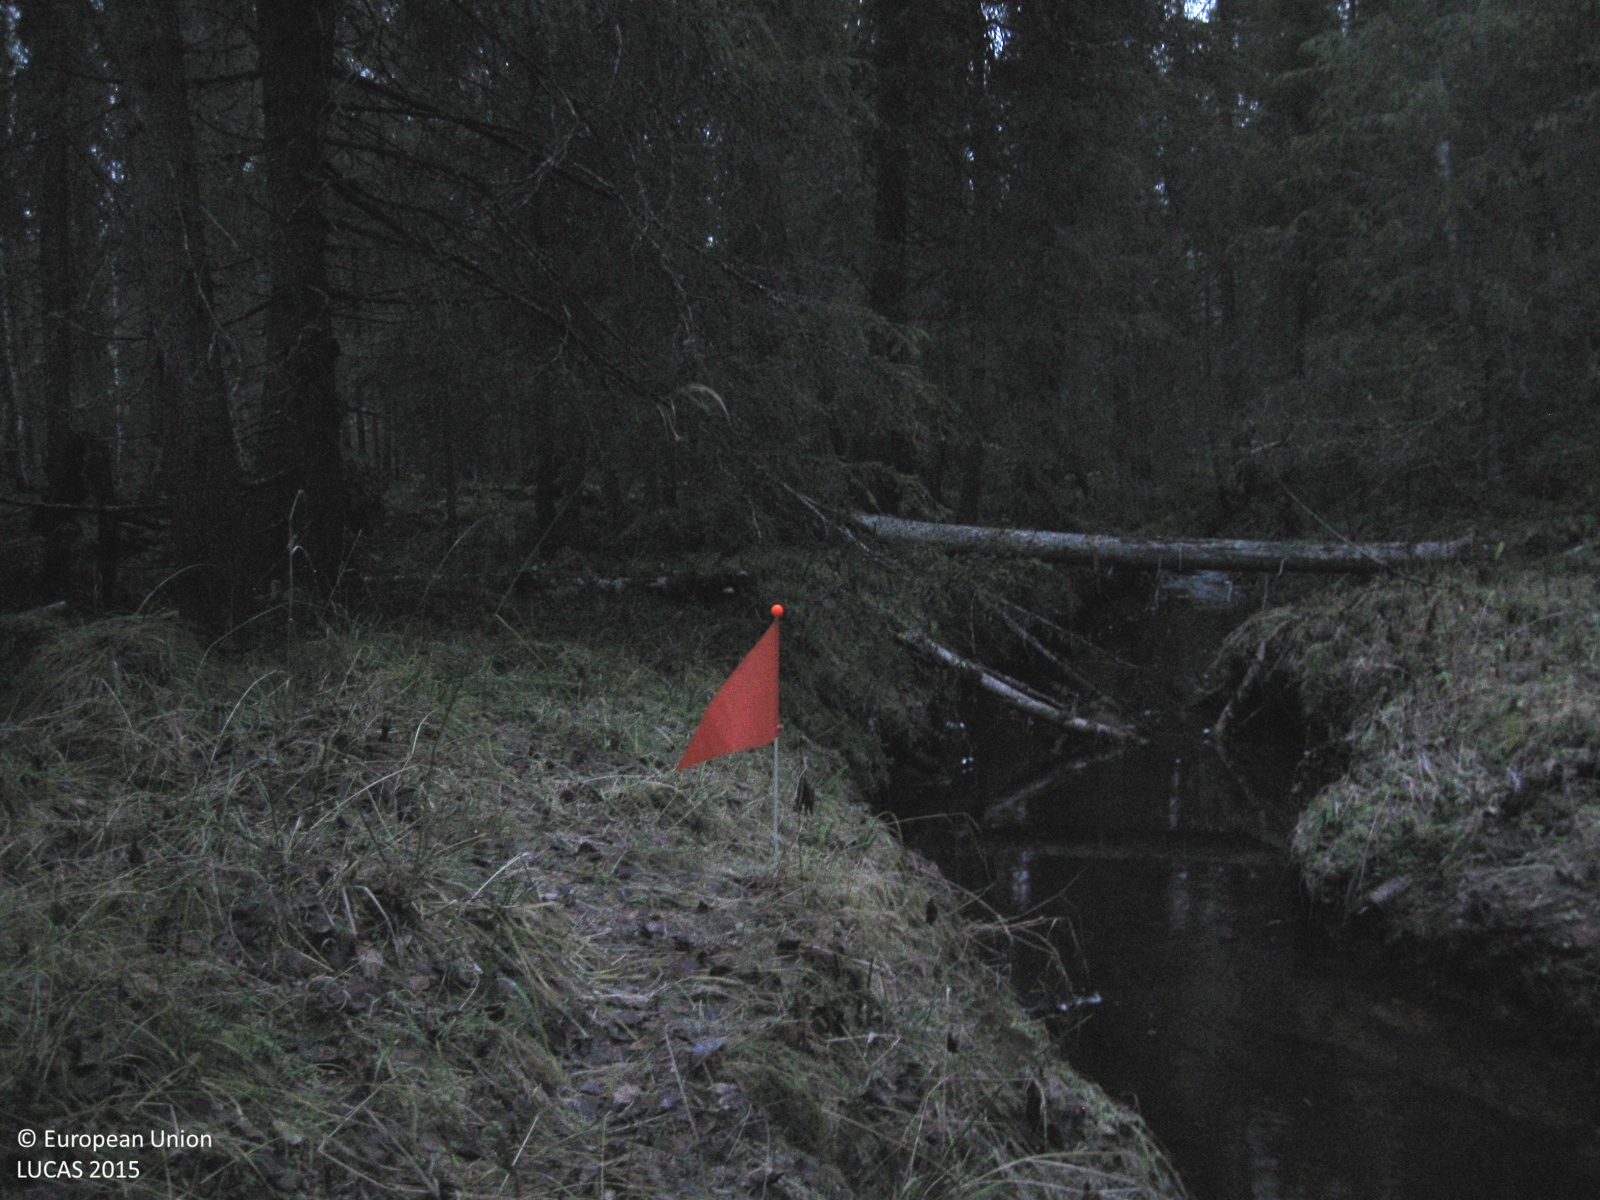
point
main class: Woodland
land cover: Spruce dominated mixed woodland
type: boreal forest
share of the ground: > 75 %
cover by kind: coniferous forest trees 50 %, broadleaved forest trees 25 %, herbaceous plants 10 %, shrubs 5 %, lichens and mosses 5 %
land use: Forestry
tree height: > 5 m
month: October
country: SE
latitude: 66.3281
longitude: 21.4143
